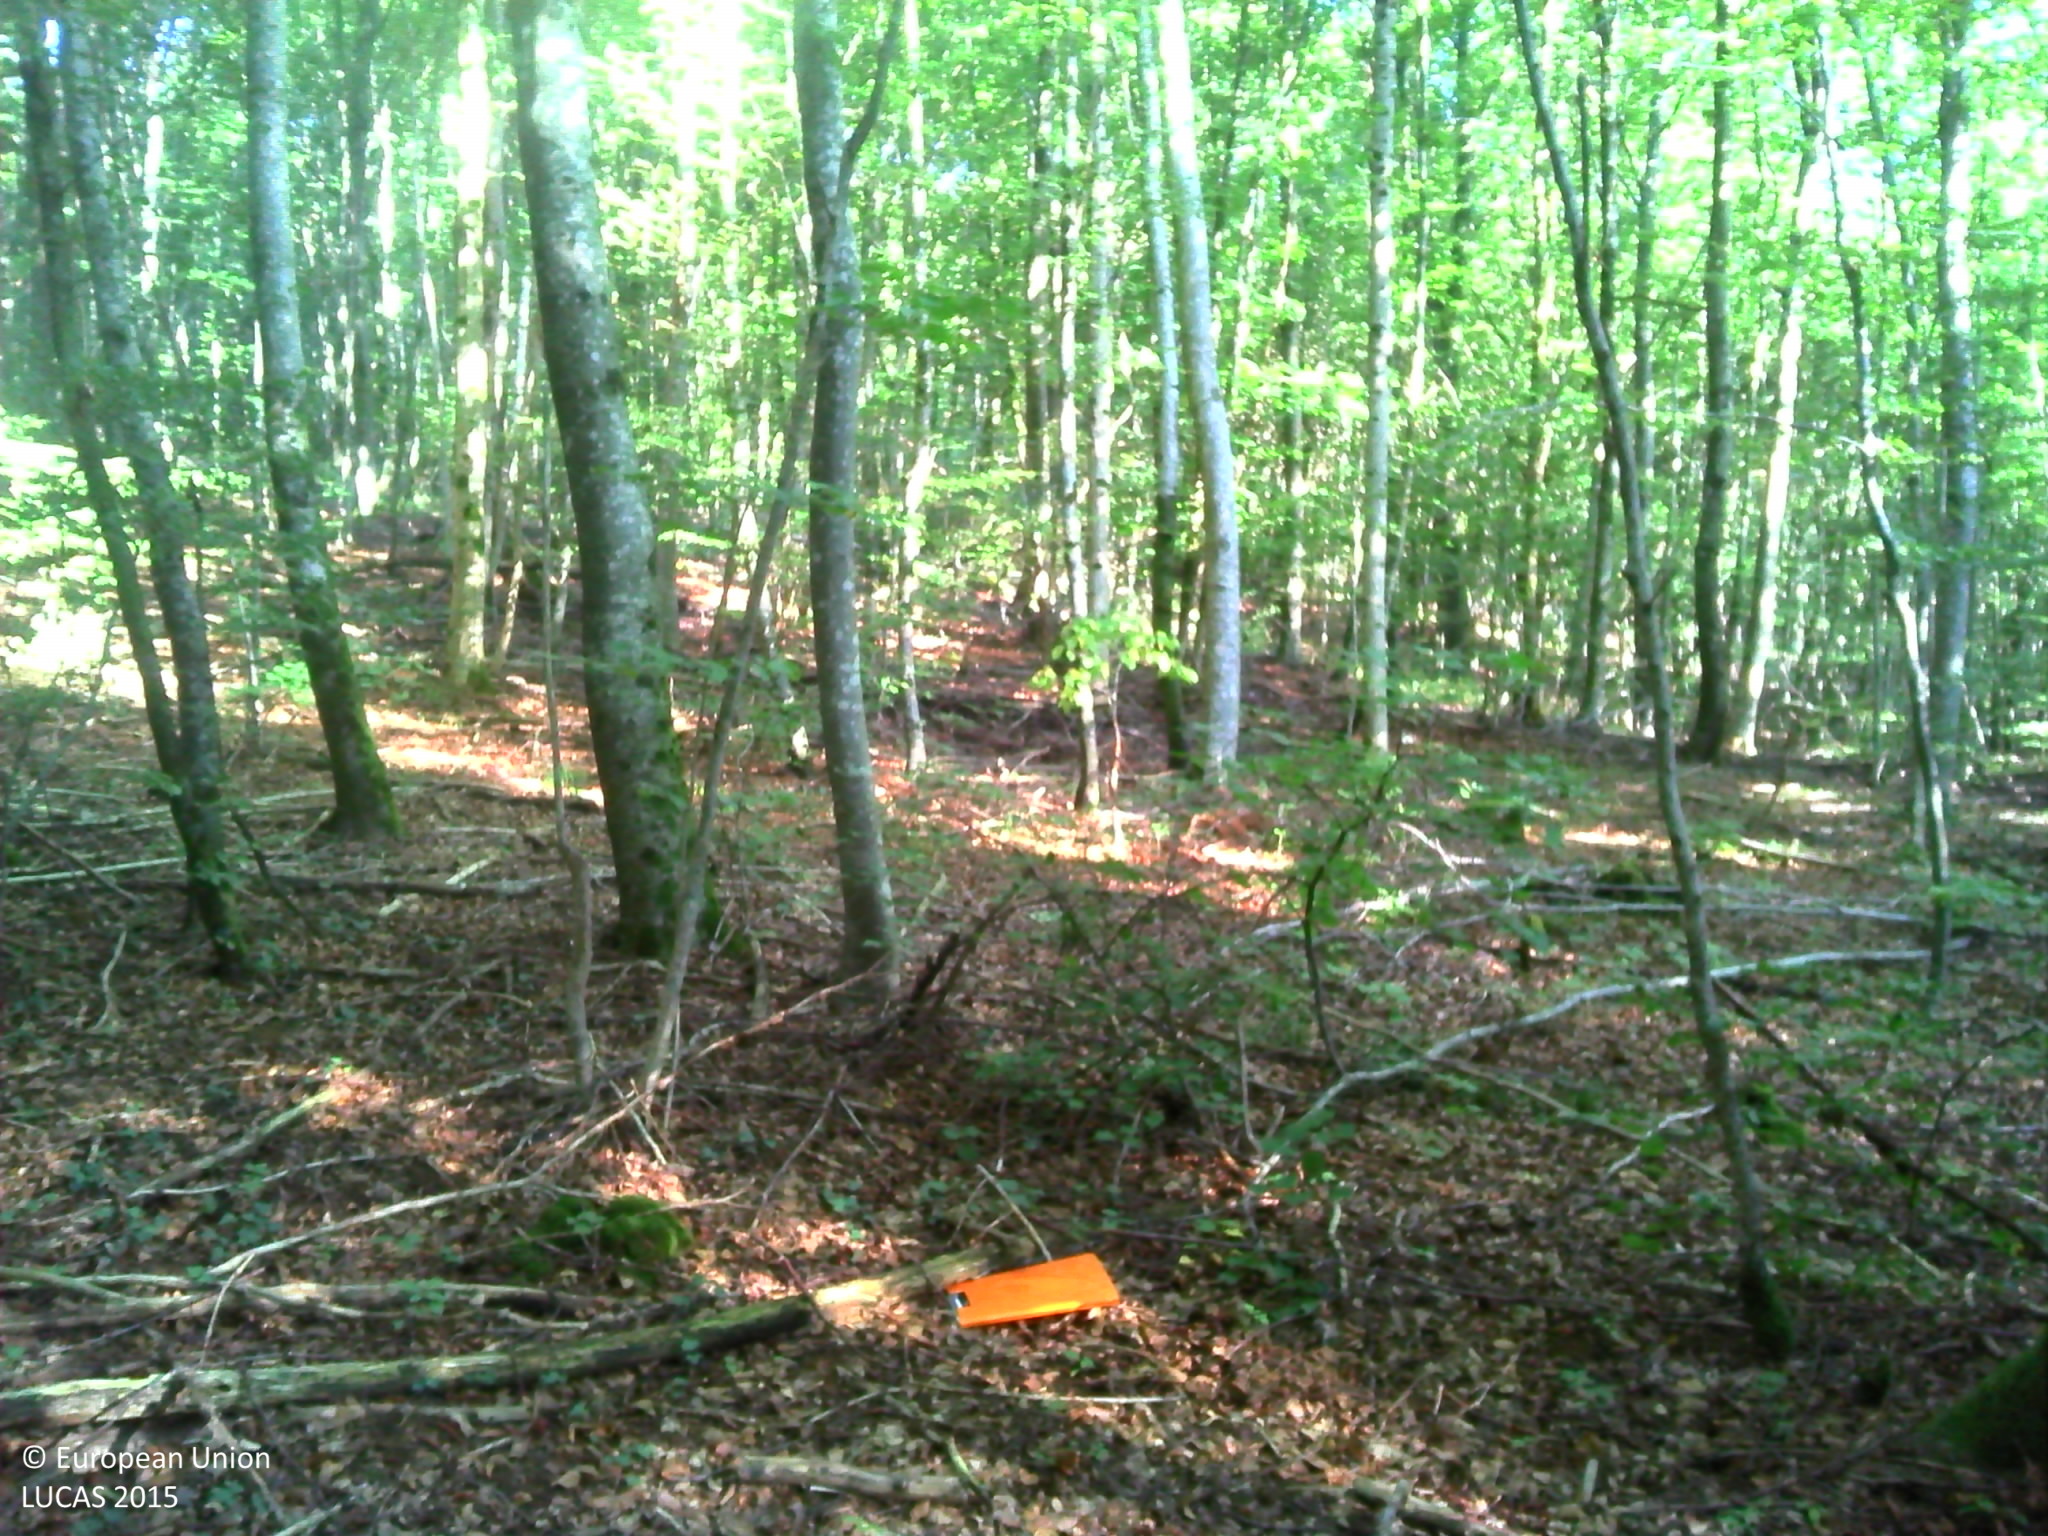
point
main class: Woodland
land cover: Broadleaved woodland
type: beech forest
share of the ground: > 75 %
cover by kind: broadleaved forest trees 100 %
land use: Forestry
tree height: > 5 m
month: September
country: FR
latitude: 47.3348
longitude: 6.3625
